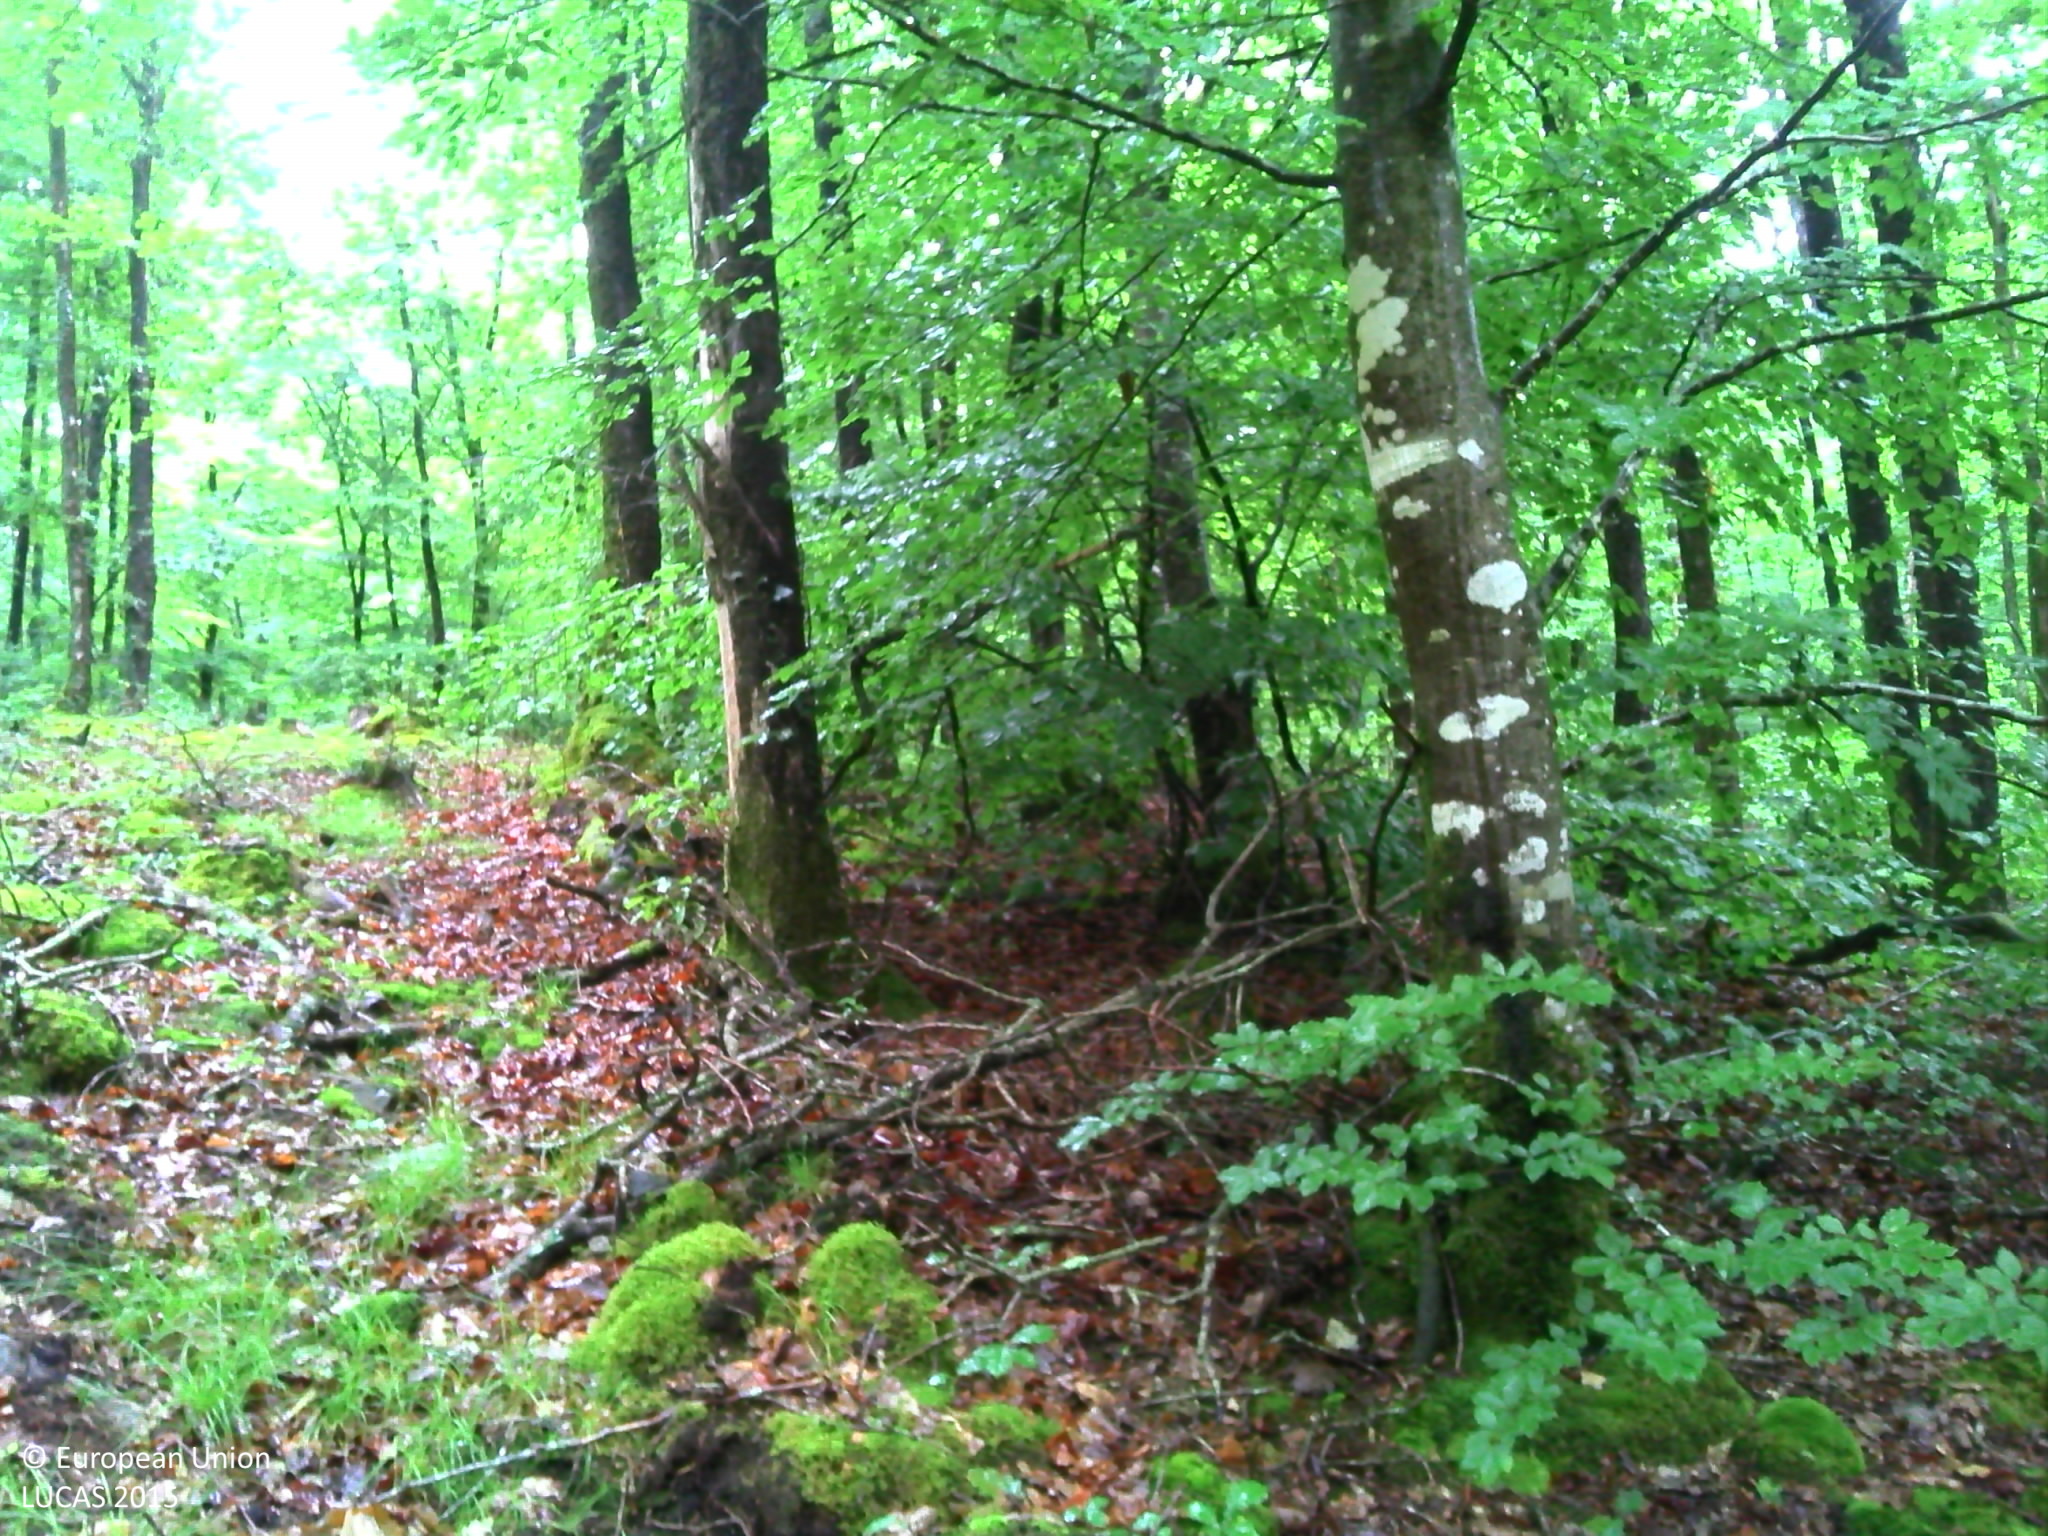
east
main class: Woodland
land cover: Broadleaved woodland
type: acidophilous oak and oak-birch forest
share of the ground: > 75 %
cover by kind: broadleaved forest trees 70 %, lichens and mosses 10 %, consolidated bare surface 10 %, shrubs 5 %, herbaceous plants 5 %
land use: Forestry
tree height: > 5 m
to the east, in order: Broadleaved woodland; Paved roads, cycling and walking lanes; Broadleaved woodland
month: July
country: FR
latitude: 47.8051
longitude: -2.9239
